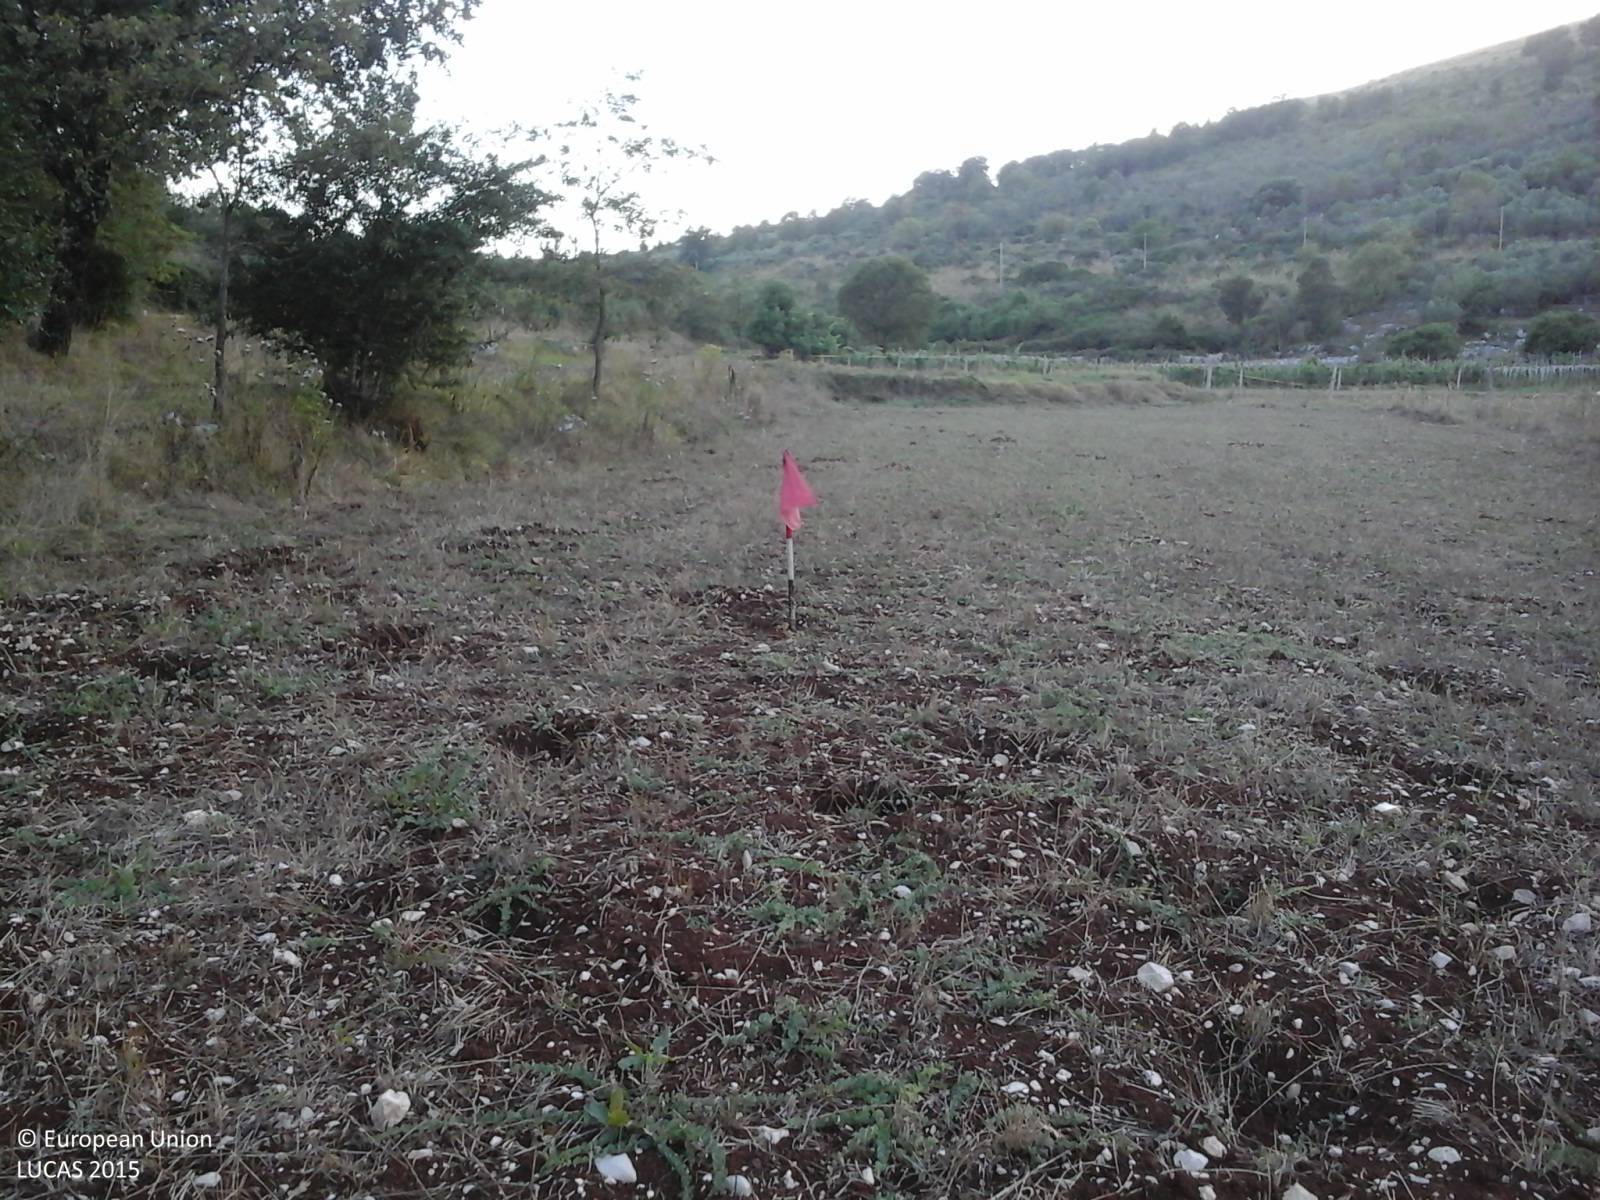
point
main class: Cropland
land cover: Temporary grasslands
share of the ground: 50 - 75 %
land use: Agriculture (excluding fallow land and kitchen gardens)
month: August
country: IT
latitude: 41.3830
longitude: 13.4661
